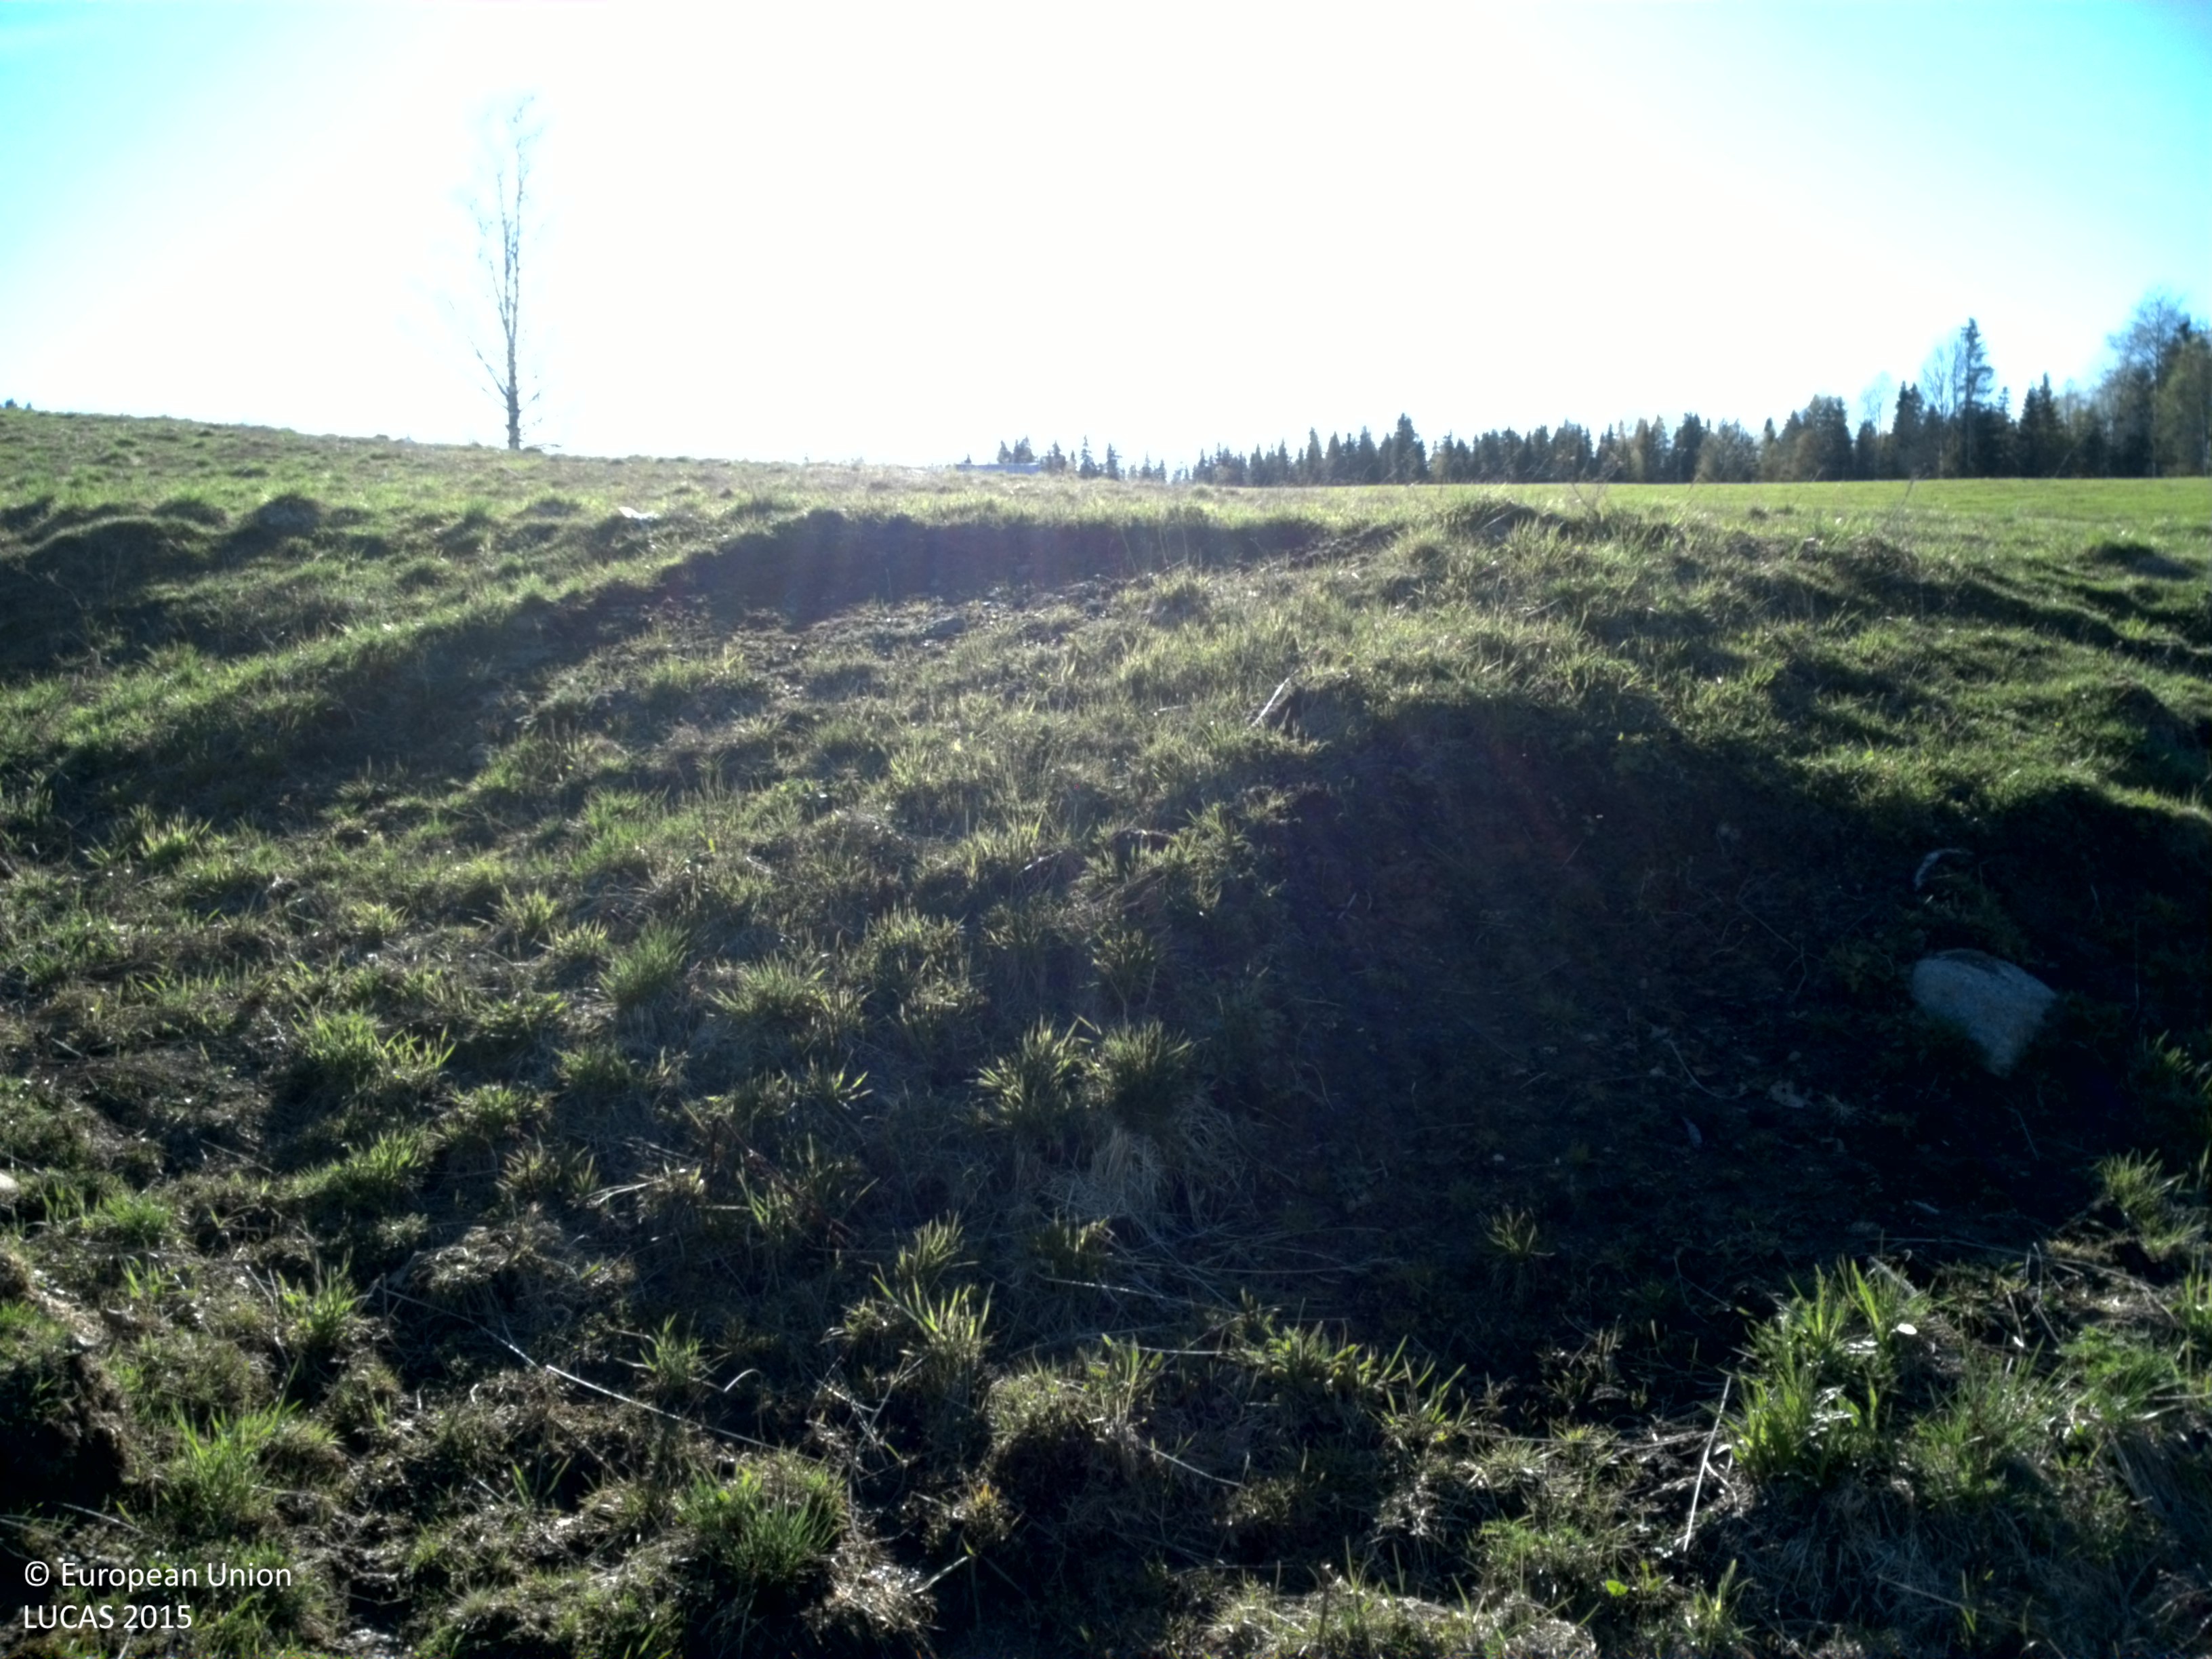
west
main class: Grassland
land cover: Grassland without tree/shrub cover
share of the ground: > 75 %
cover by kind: herbaceous plants 100 %
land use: Agriculture (excluding fallow land and kitchen gardens)
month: May
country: SE
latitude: 66.0918
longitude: 23.3661
